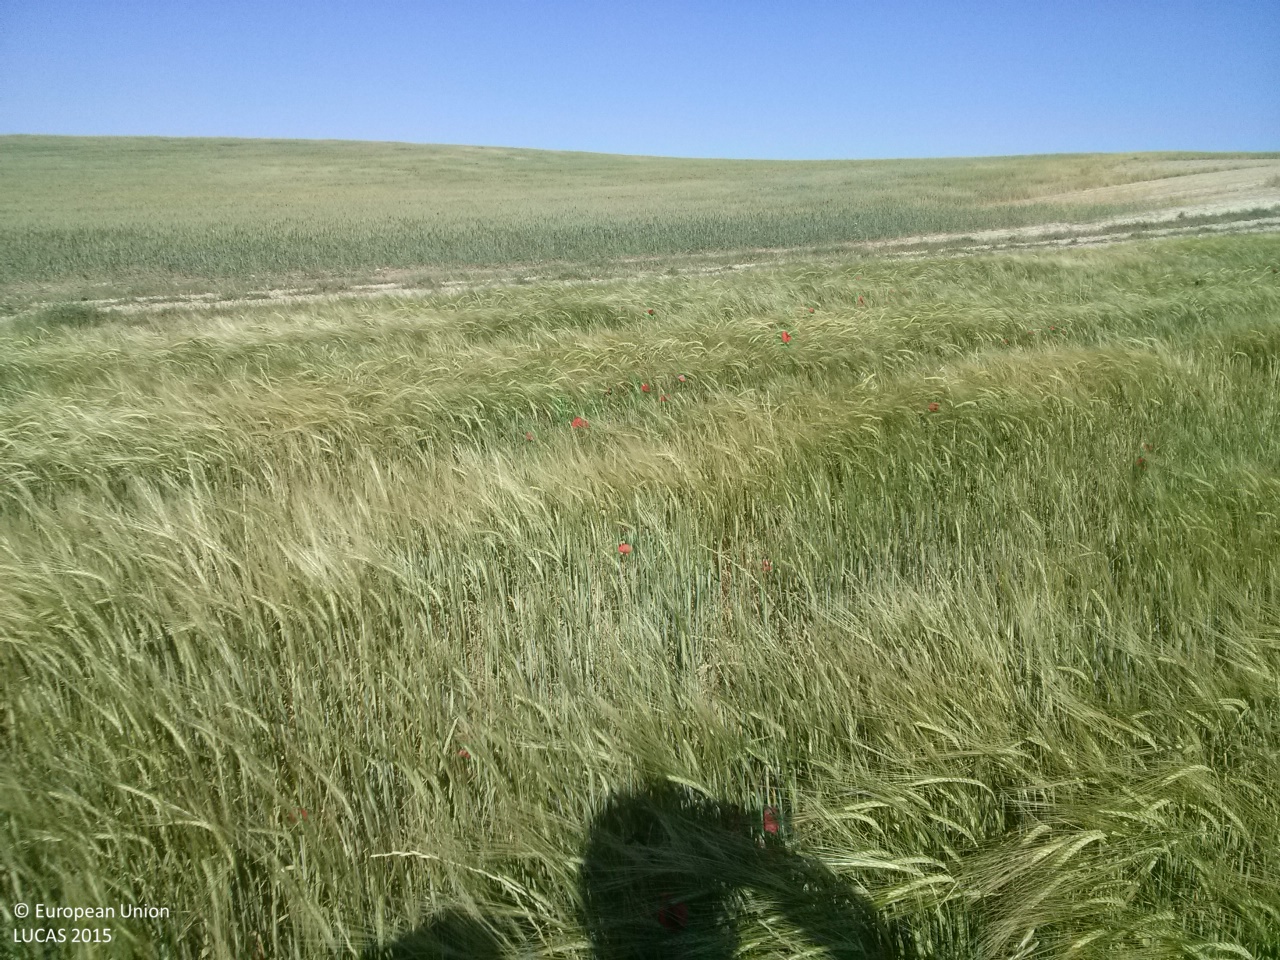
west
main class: Cropland
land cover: Barley
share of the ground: > 75 %
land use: Agriculture (excluding fallow land and kitchen gardens)
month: May
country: ES
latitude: 40.1679
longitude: -2.7158
